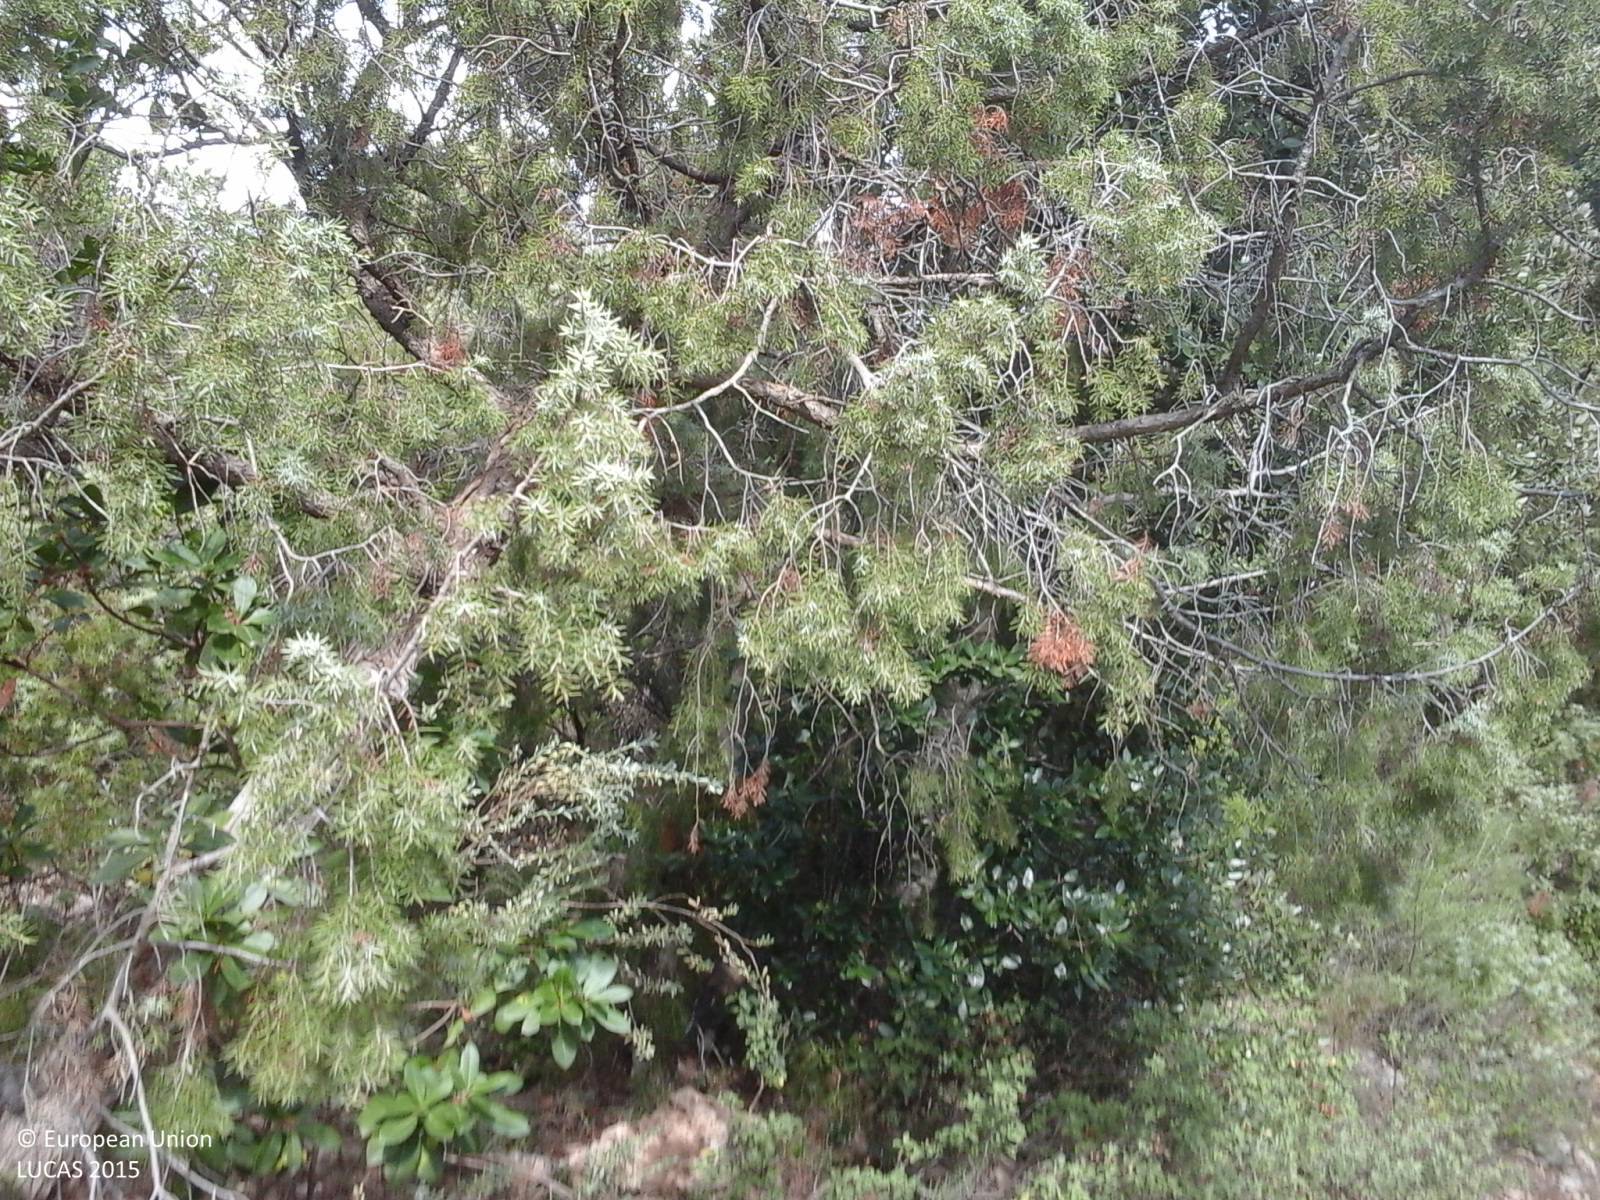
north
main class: Woodland
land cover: Broadleaved woodland
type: broadleaved evergreen forest
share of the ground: > 75 %
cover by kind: broadleaved forest trees 80 %, shrubs 15 %, herbaceous plants 5 %
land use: Semi-natural and natural areas not in use
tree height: > 5 m
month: September
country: IT
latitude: 39.8131
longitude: 9.4541
